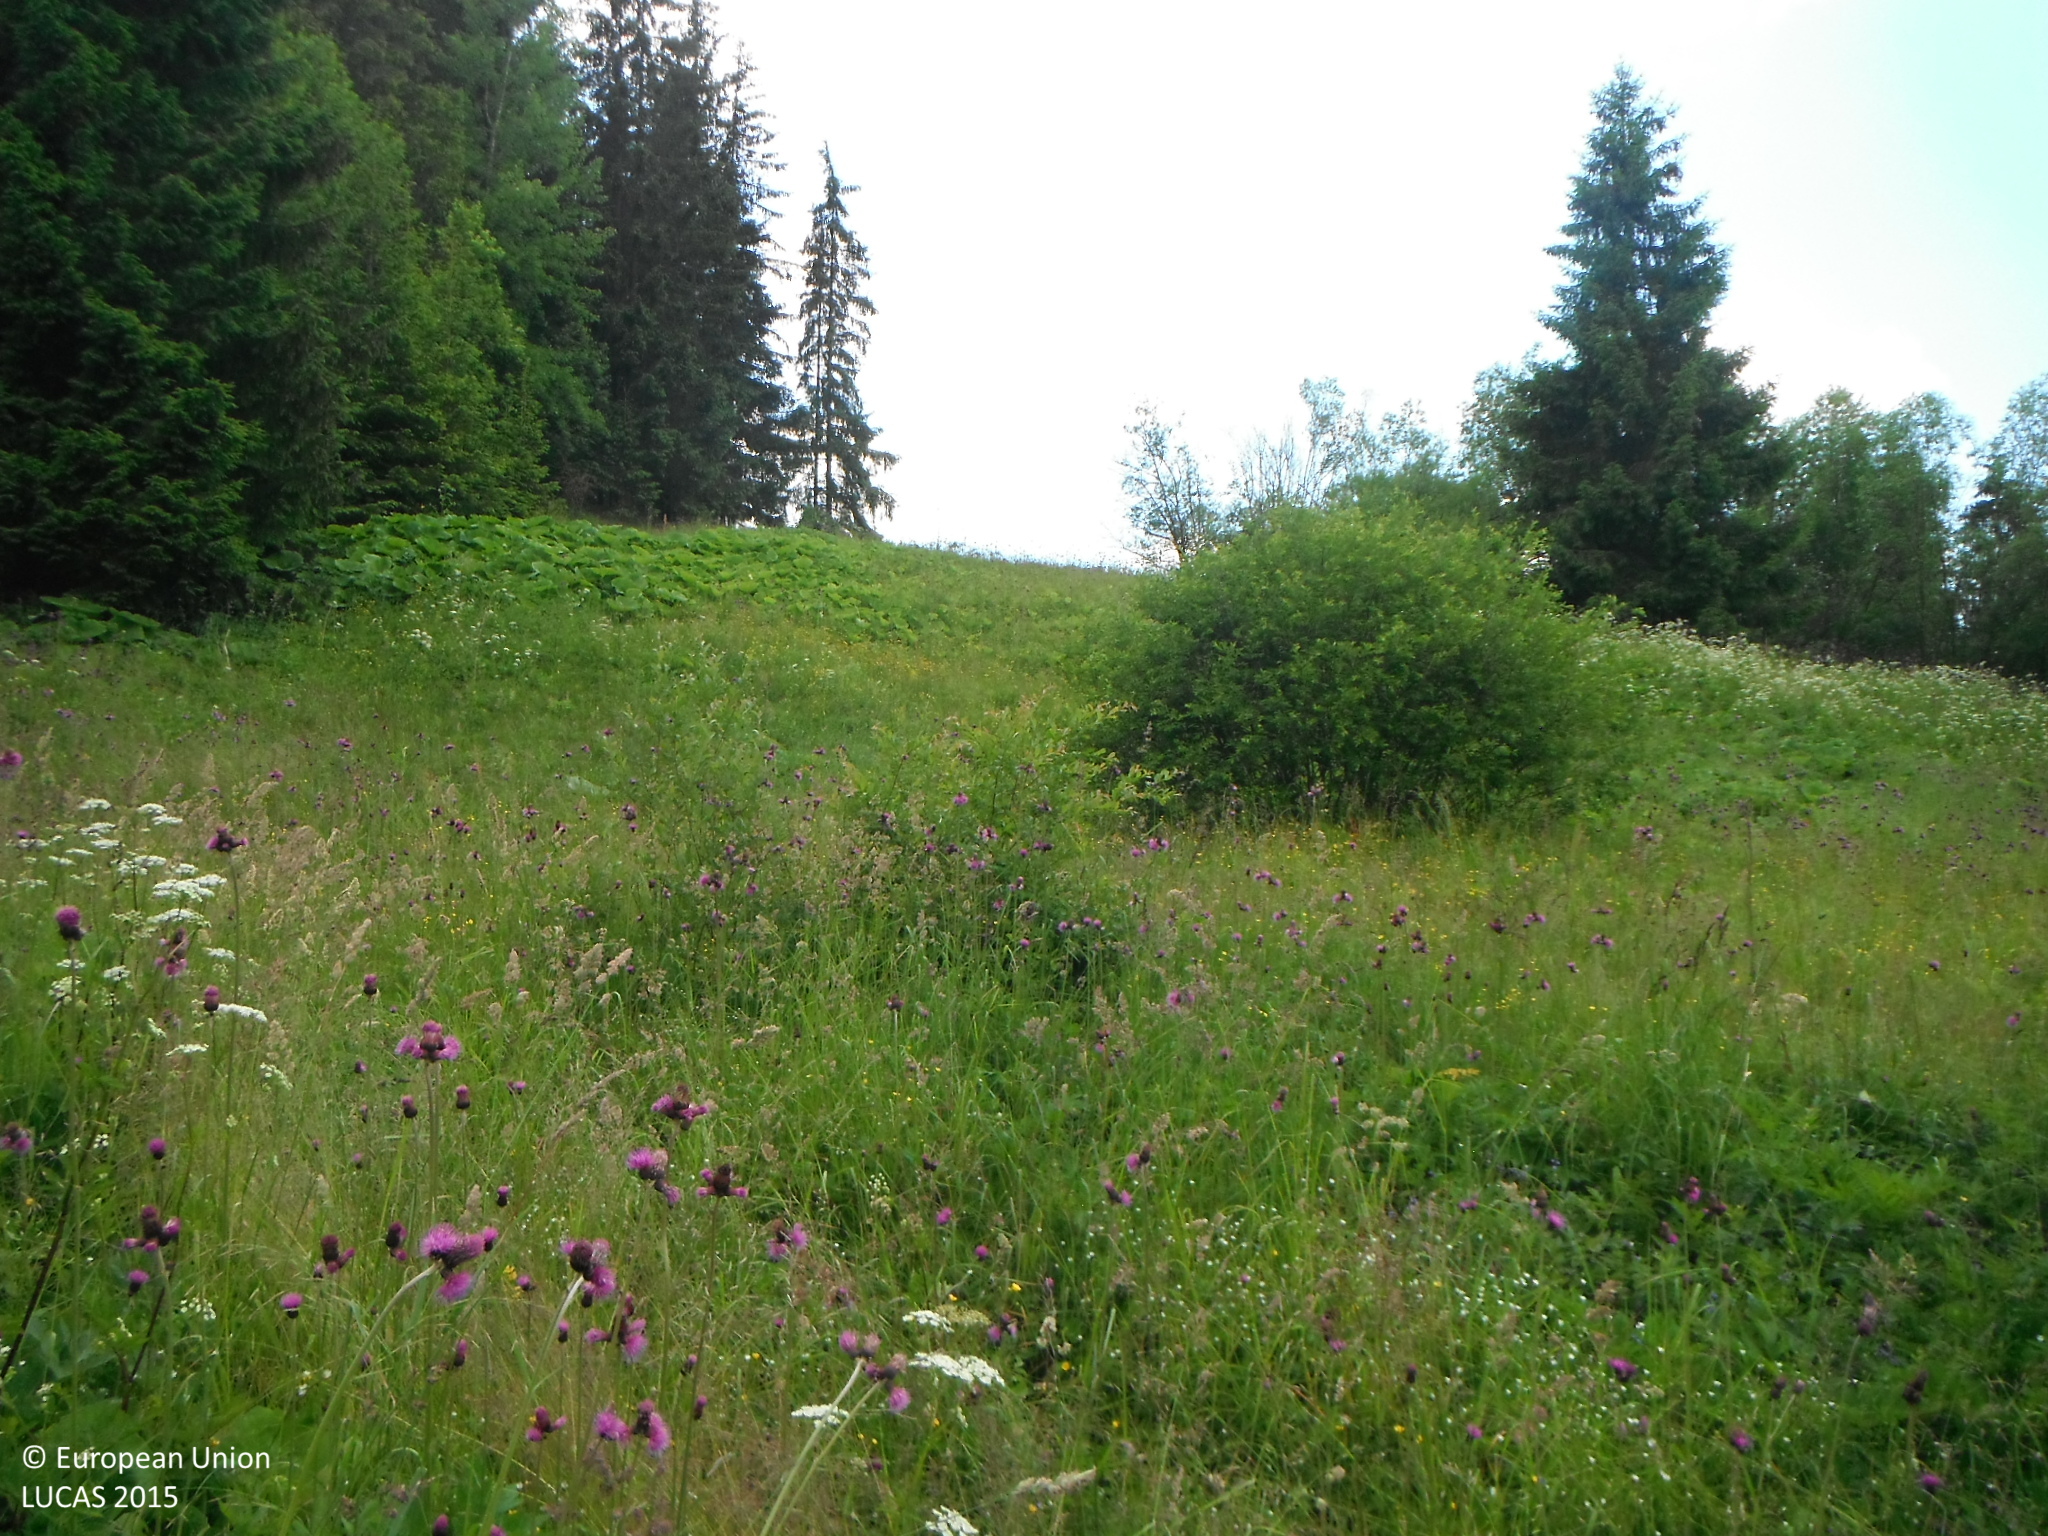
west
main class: Grassland
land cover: Spontaneously vegetated surfaces
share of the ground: > 75 %
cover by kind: herbaceous plants 100 %
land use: Semi-natural and natural areas not in use
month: July
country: SK
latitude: 49.4431
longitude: 19.2790
